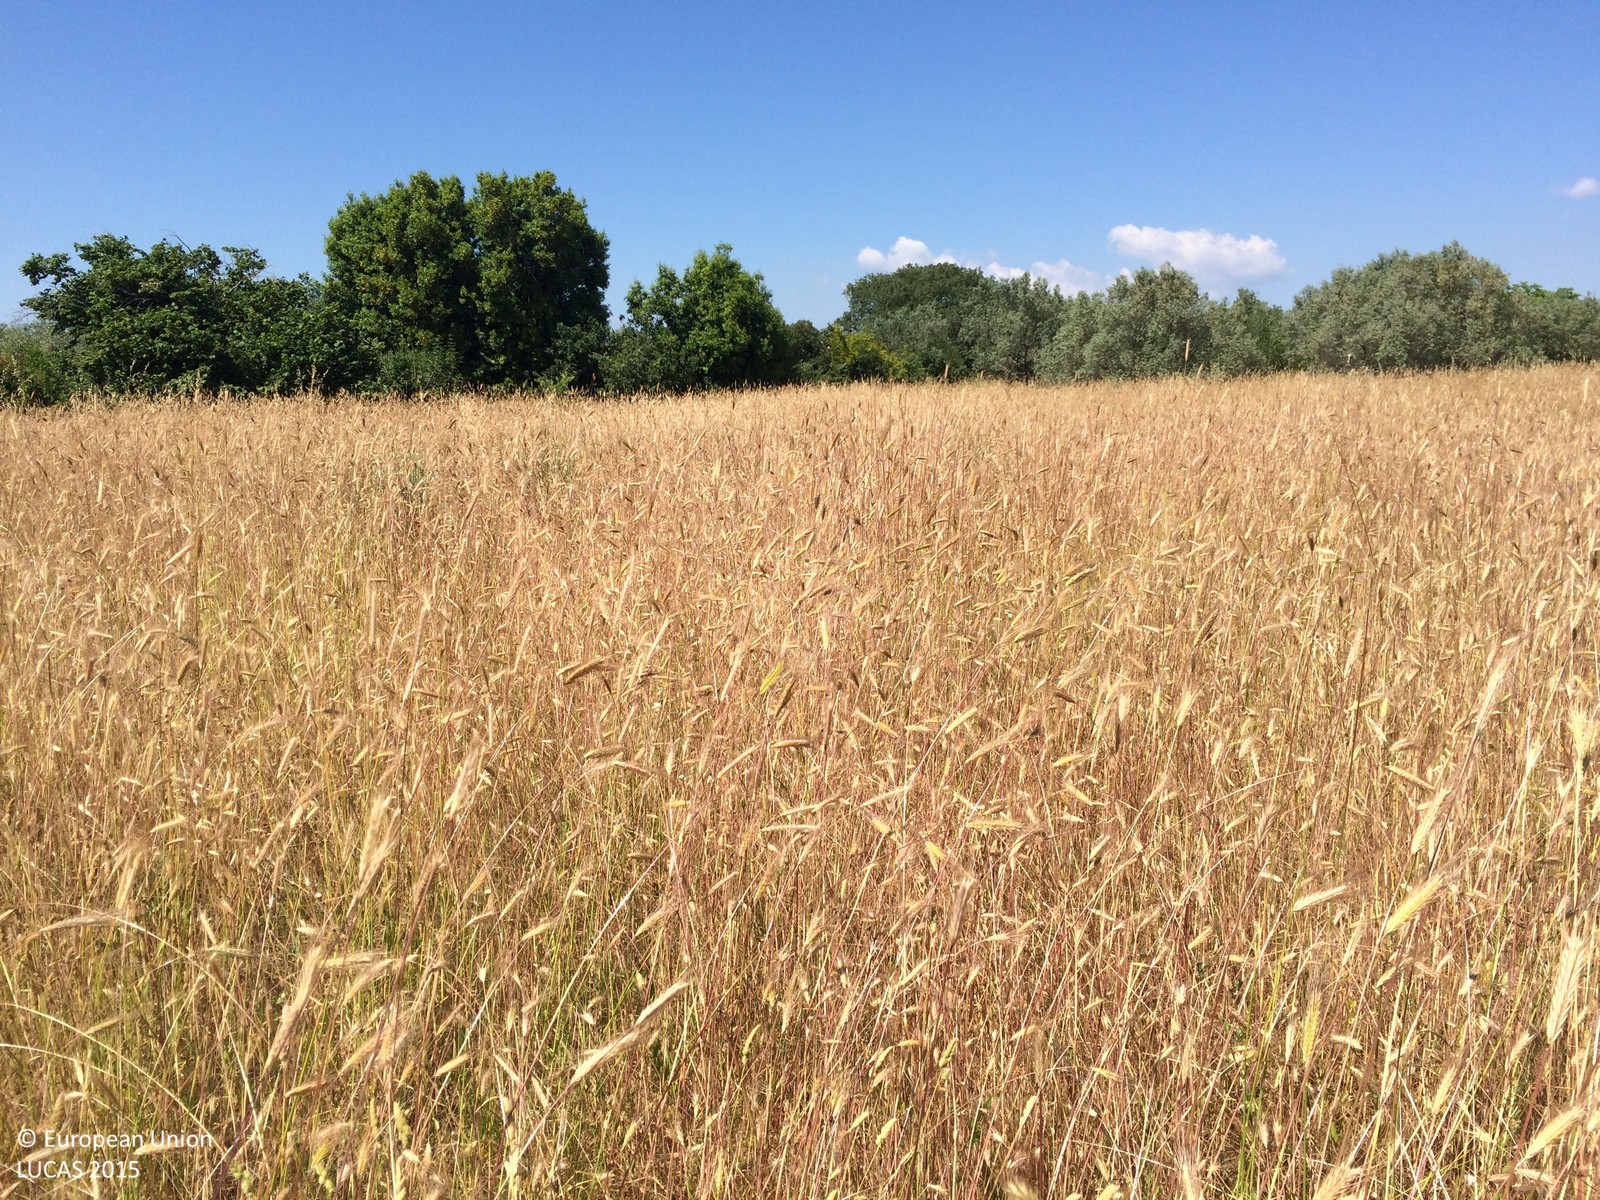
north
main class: Grassland
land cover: Grassland without tree/shrub cover
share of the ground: > 75 %
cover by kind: herbaceous plants 100 %
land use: Agriculture (excluding fallow land and kitchen gardens)
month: June
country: HR
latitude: 44.9305
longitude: 13.8081
